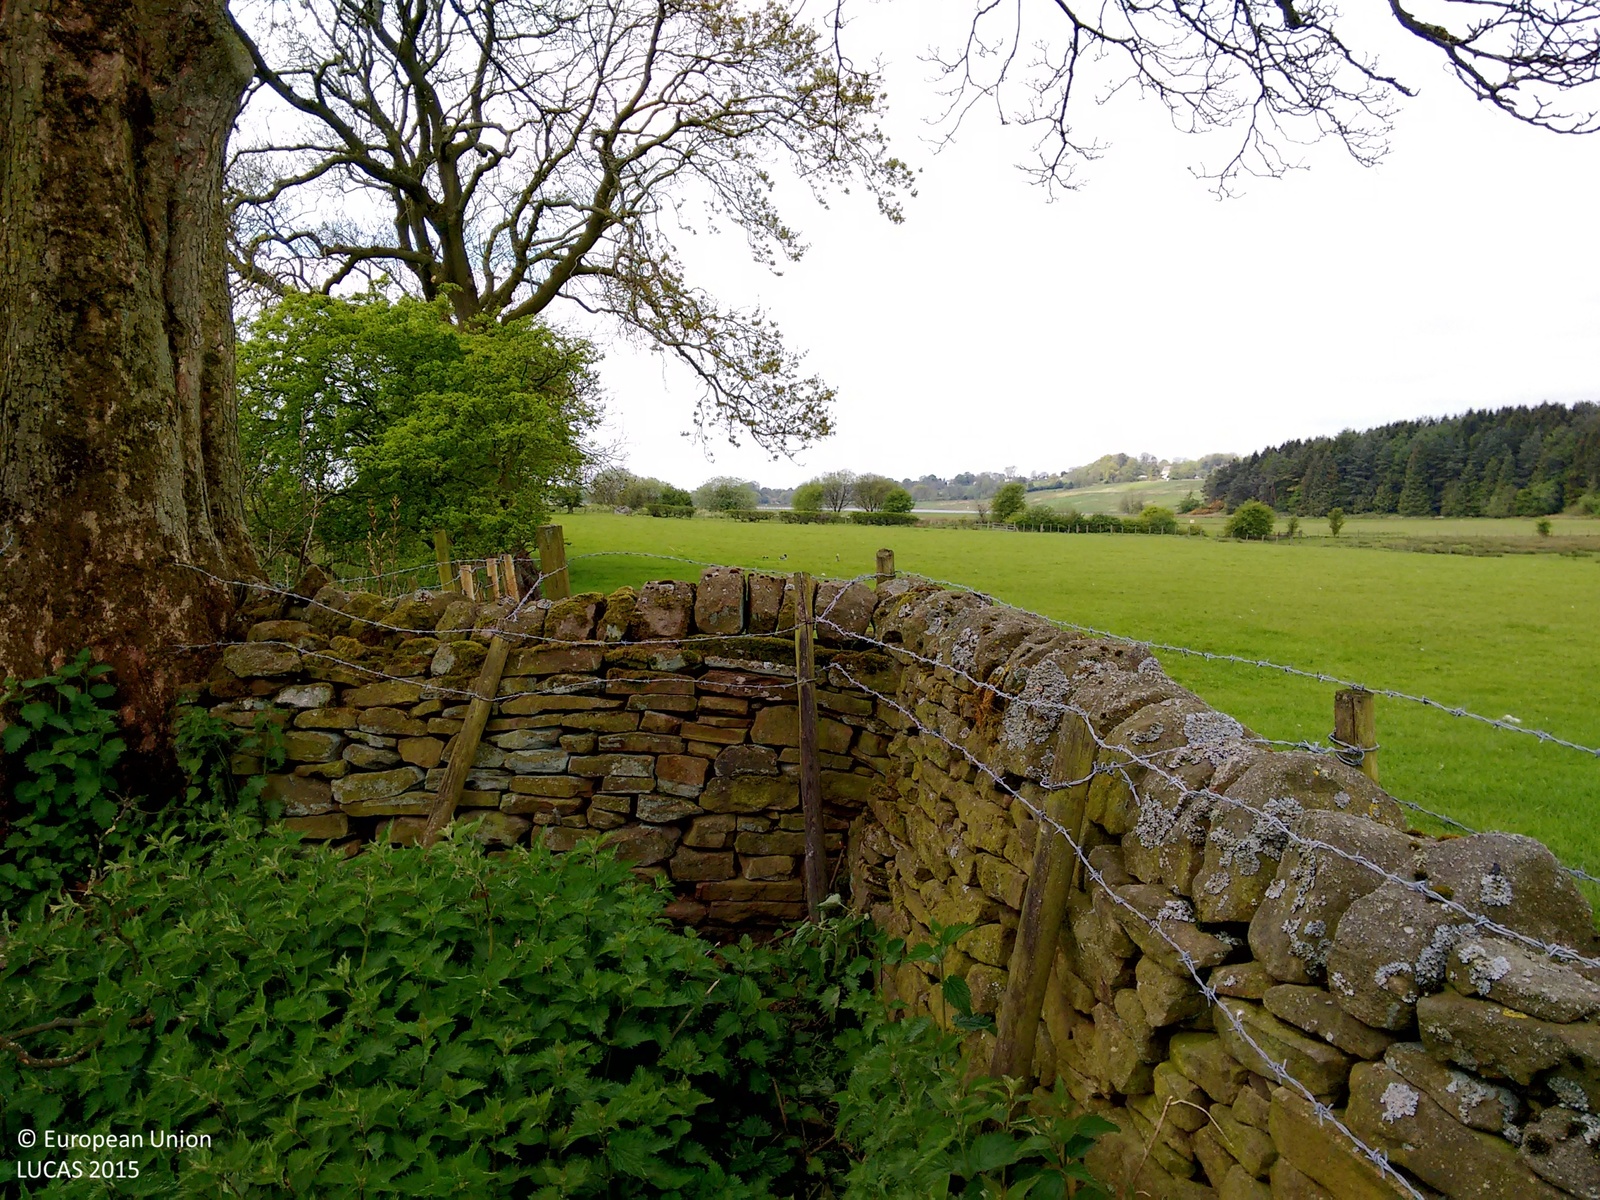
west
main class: Grassland
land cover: Grassland without tree/shrub cover
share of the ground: > 75 %
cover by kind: herbaceous plants 100 %
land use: Agriculture (excluding fallow land and kitchen gardens)
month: May
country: GB
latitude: 53.8359
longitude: -2.5724
